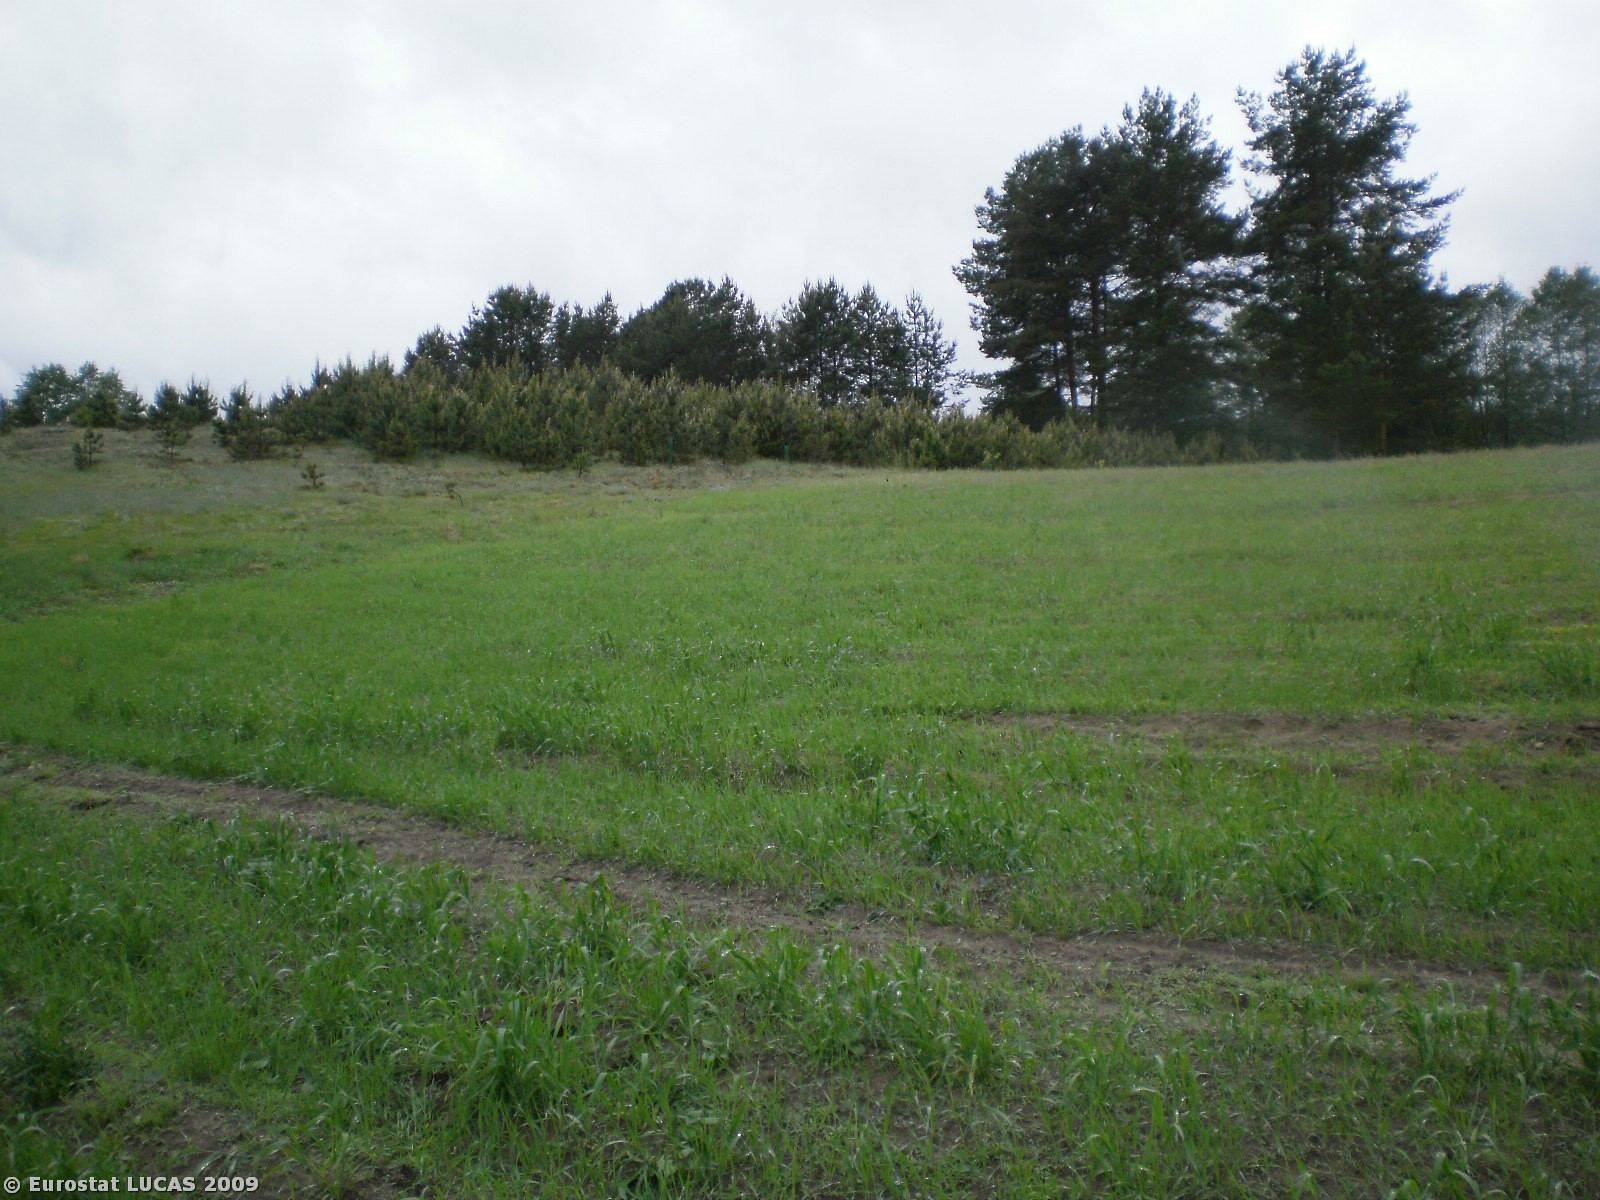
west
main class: Grassland
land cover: Grassland without tree/shrub cover
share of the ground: > 75 %
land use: Agriculture (excluding fallow land and kitchen gardens)
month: May
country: PL
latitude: 53.8738
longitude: 18.0606
